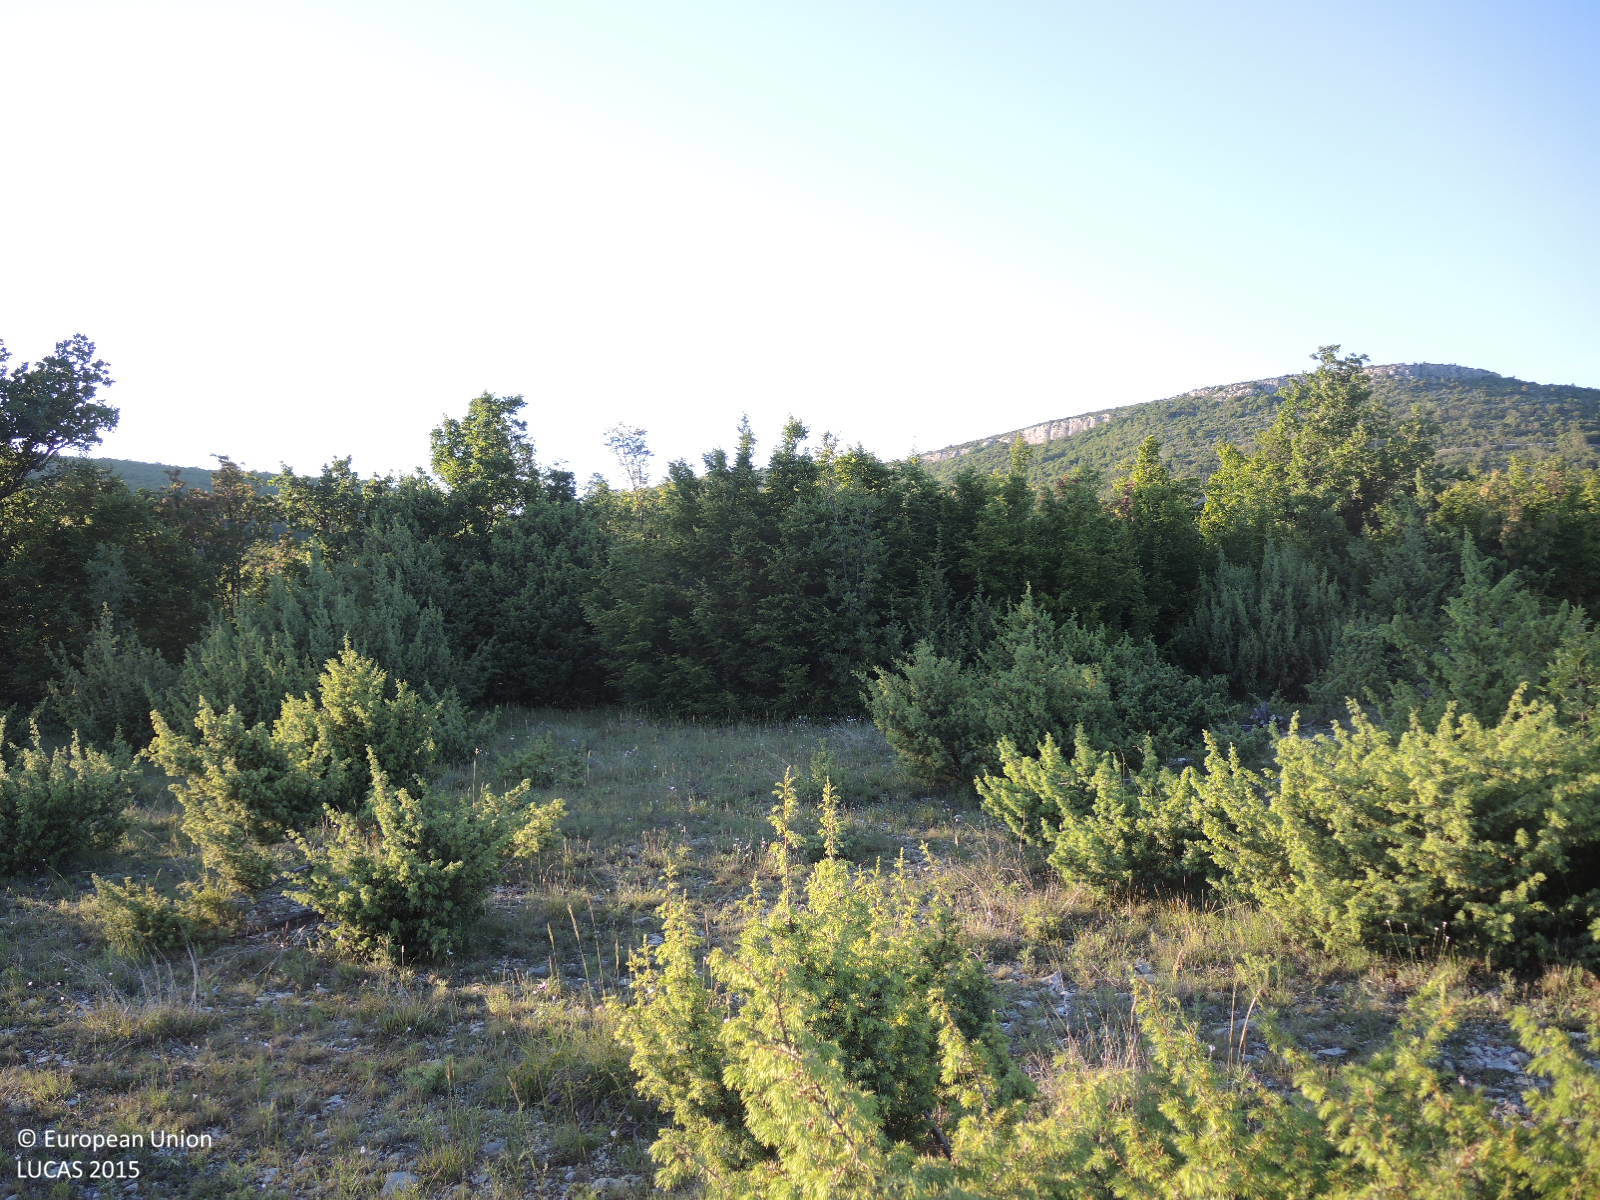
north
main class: Shrubland
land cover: Shrubland with sparse tree cover
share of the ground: 25 - 50 %
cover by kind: shrubs 40 %, herbaceous plants 35 %, unconsolidated bare surface 15 %, broadleaved forest trees 5 %, consolidated bare surface 5 %
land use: Semi-natural and natural areas not in use
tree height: < 5 m
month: May
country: HR
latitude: 44.0661
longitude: 15.7226
